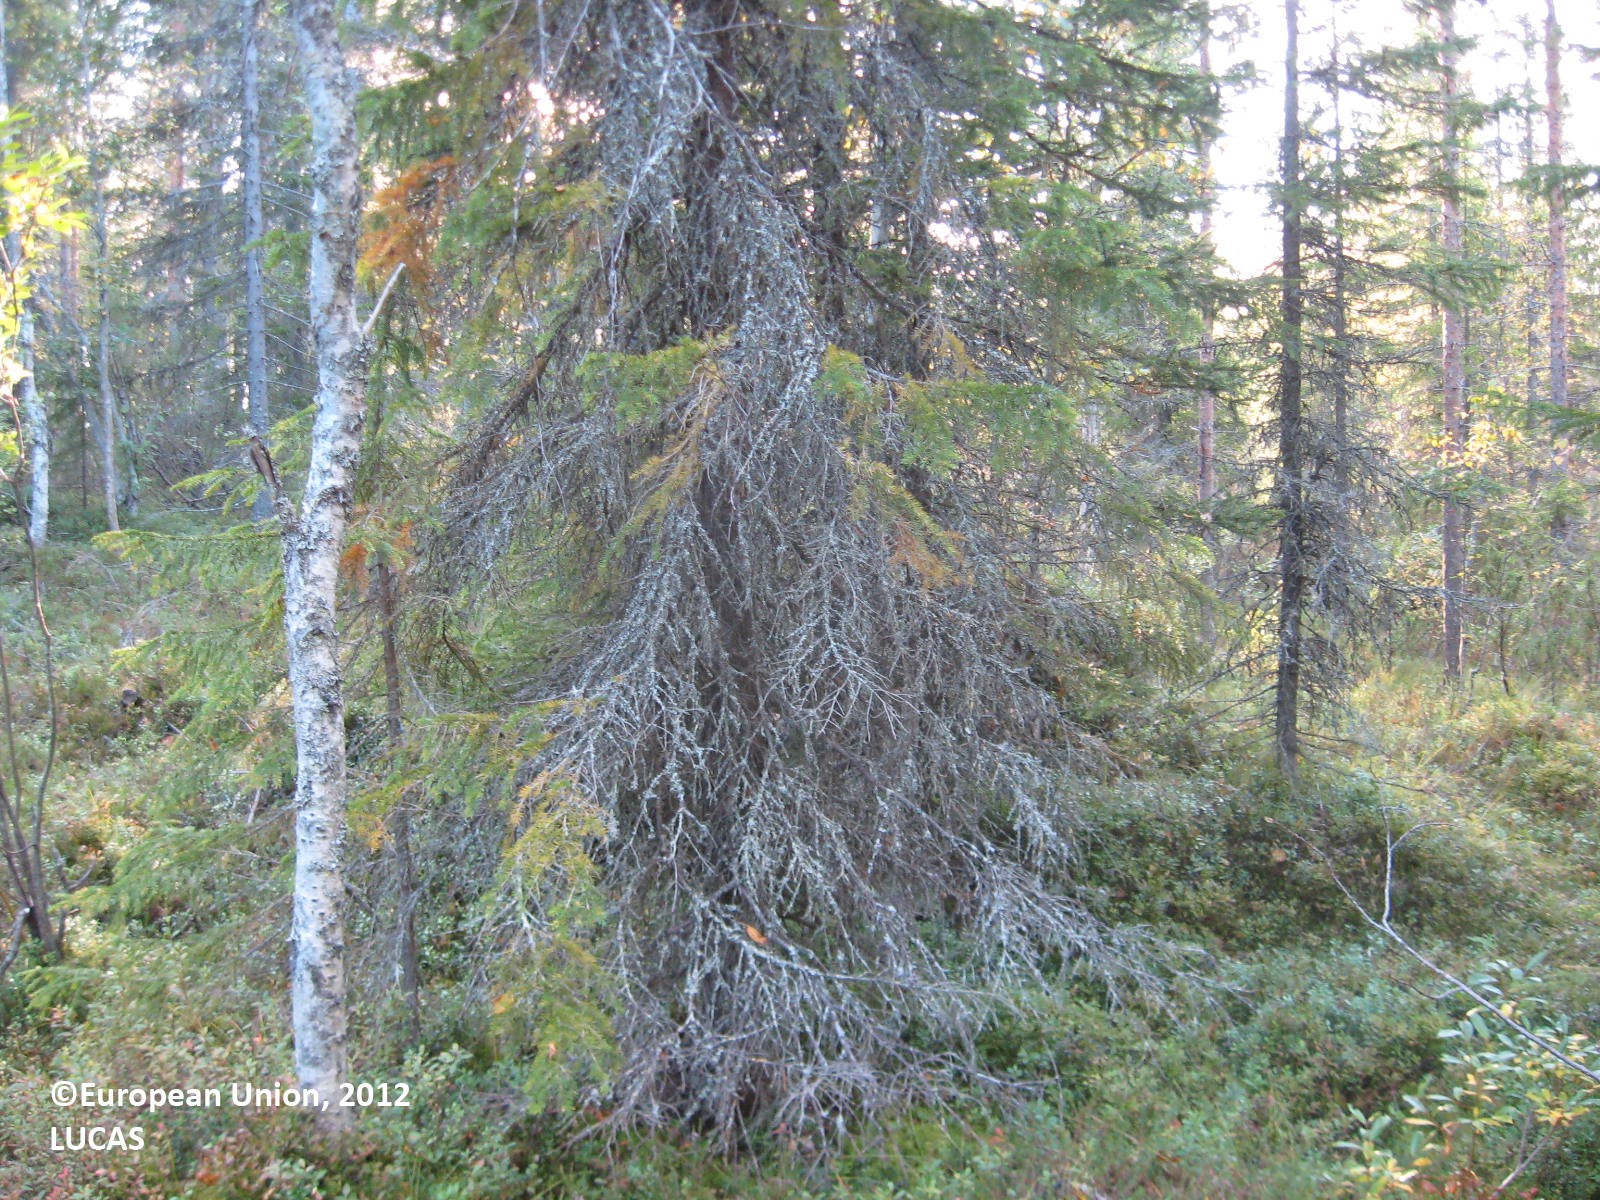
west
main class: Woodland
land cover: Pine dominated coniferous woodland
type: boreal forest
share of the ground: > 75 %
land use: Forestry
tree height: > 5 m
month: August
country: FI
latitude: 63.9506
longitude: 29.6790
